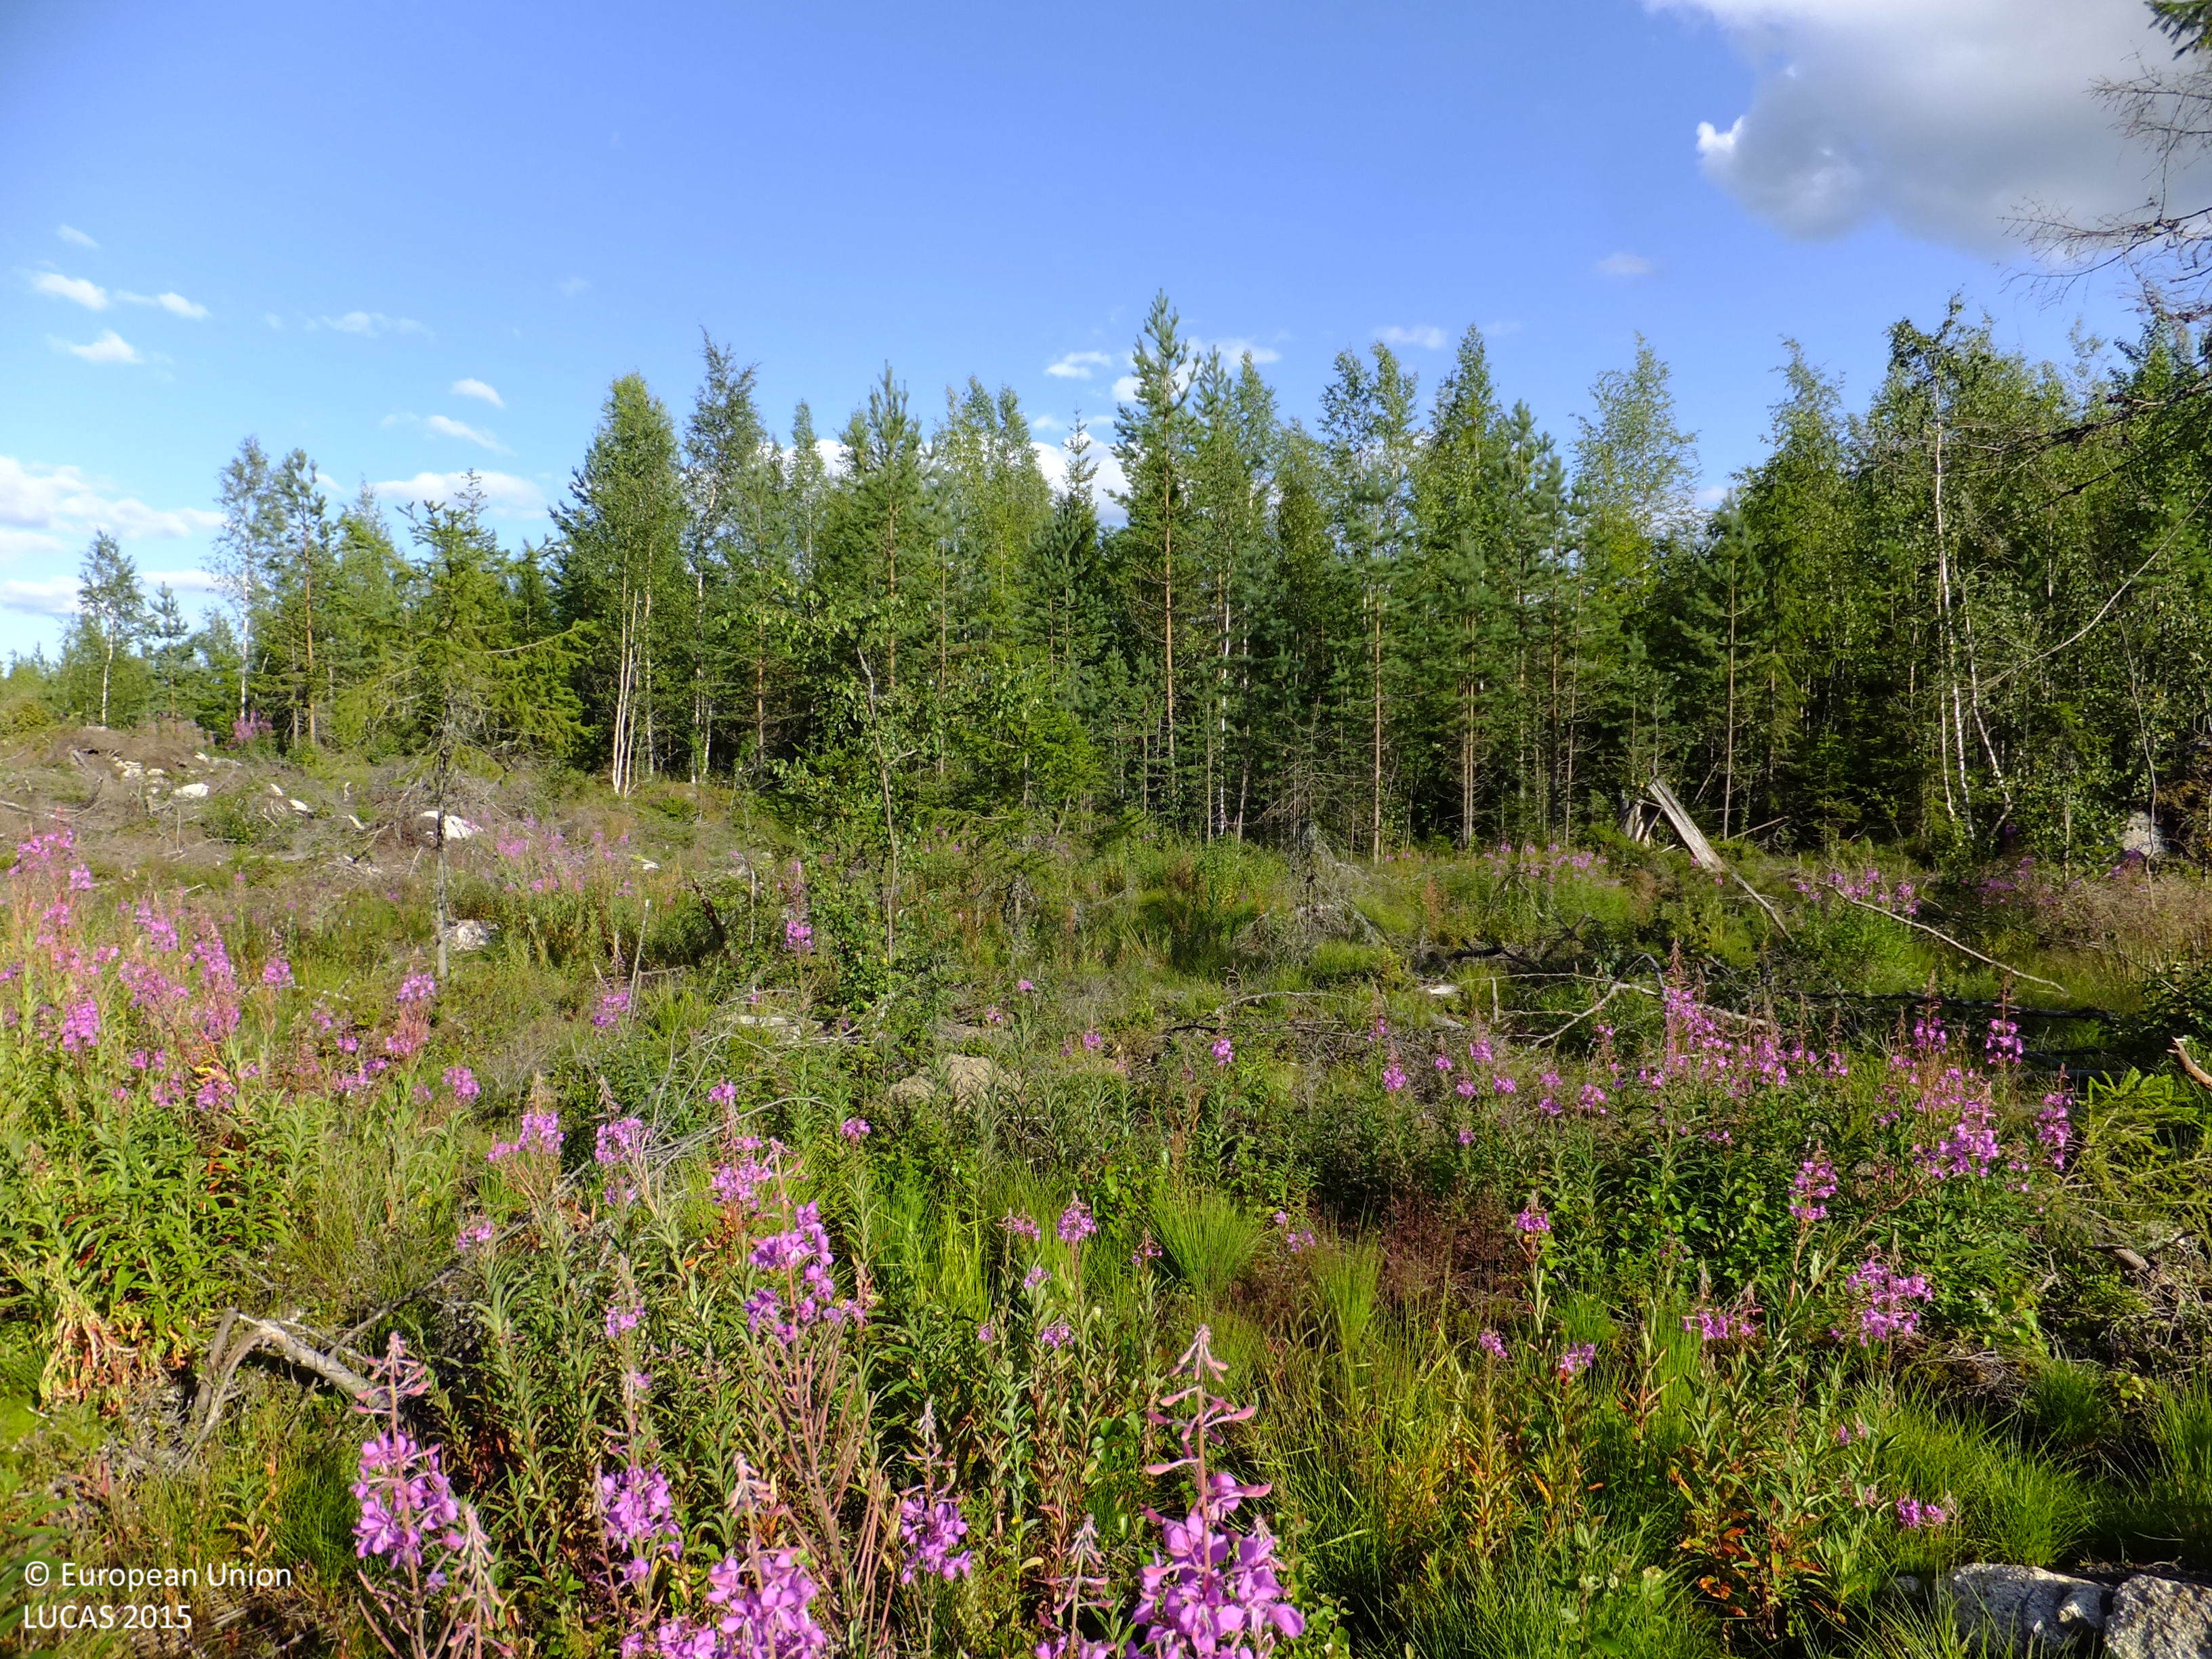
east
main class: Shrubland
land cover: Shrubland with sparse tree cover
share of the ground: > 75 %
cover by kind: herbaceous plants 40 %, unconsolidated bare surface 25 %, consolidated bare surface 20 %, shrubs 10 %, coniferous forest trees 5 %
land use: Forestry
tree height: < 5 m
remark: Clear cut
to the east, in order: Shrubland with sparse tree cover; Other mixed woodland; Pine dominated mixed woodland
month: August
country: FI
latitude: 63.1351
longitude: 22.6881
